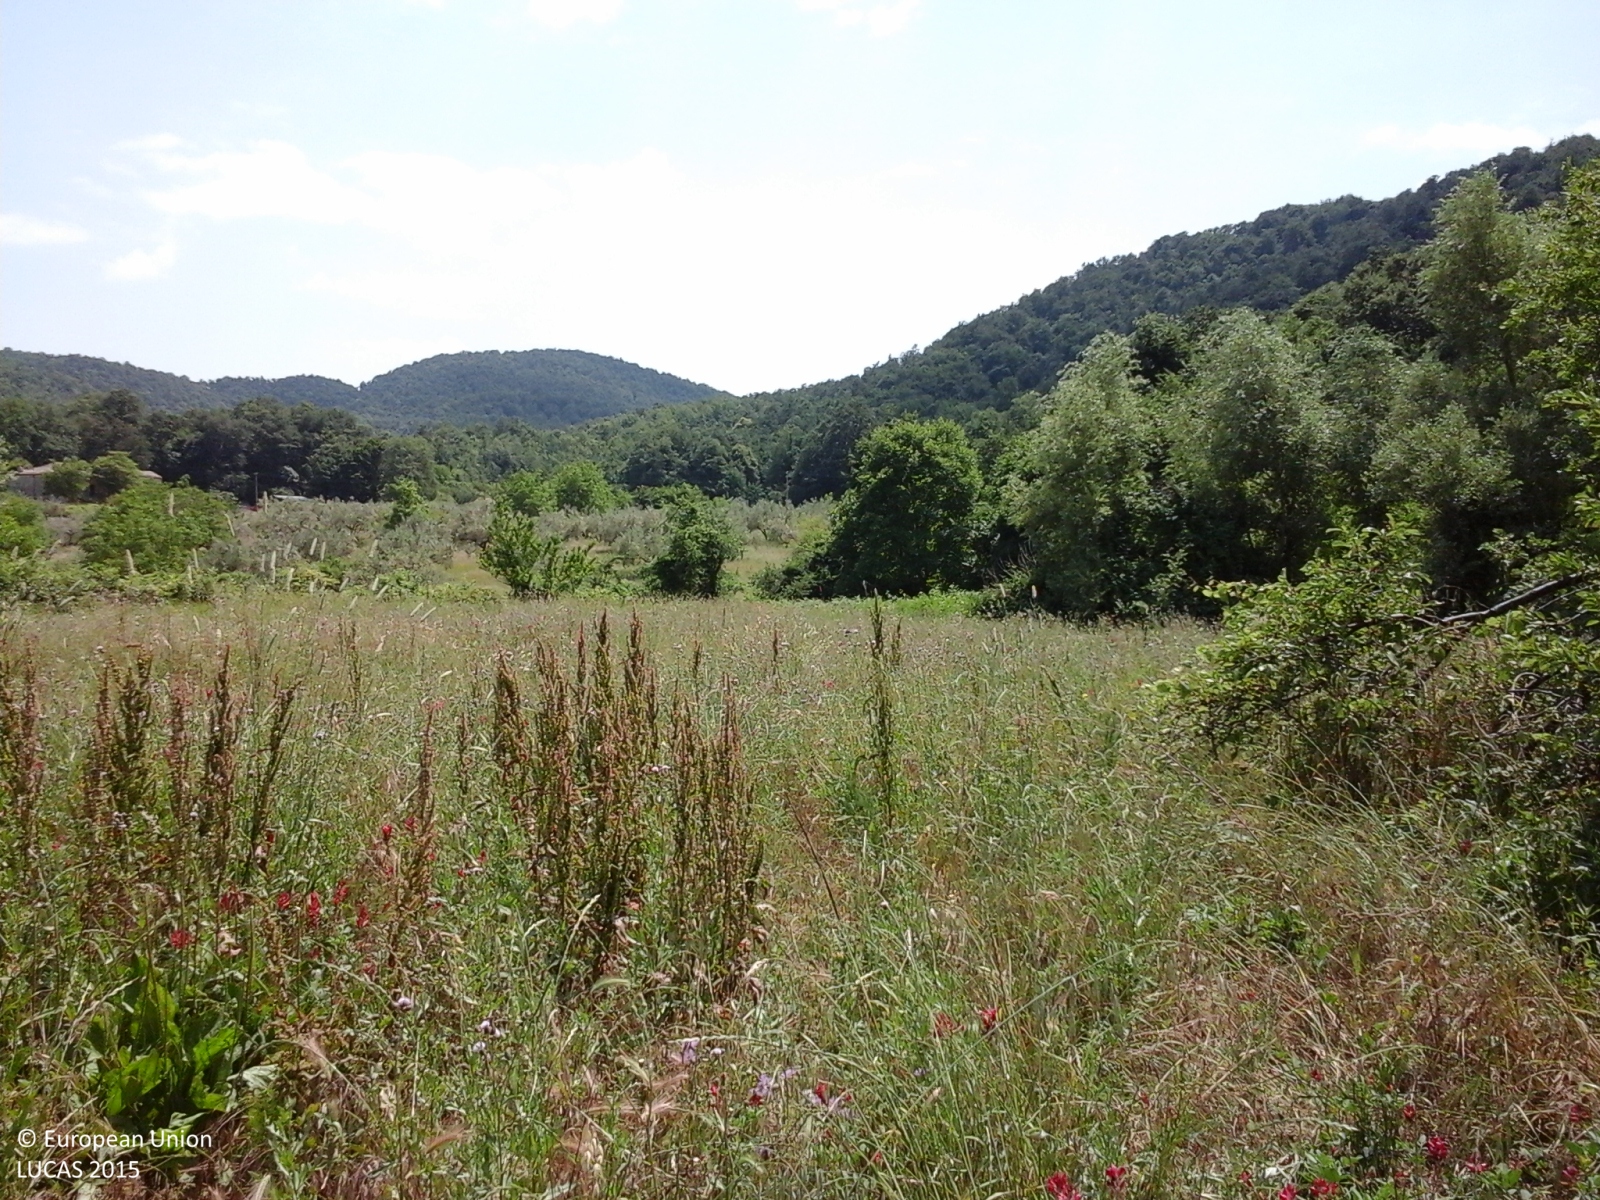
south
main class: Shrubland
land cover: Shrubland with sparse tree cover
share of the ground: > 75 %
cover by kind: shrubs 90 %, broadleaved forest trees 5 %, herbaceous plants 5 %
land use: Semi-natural and natural areas not in use
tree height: < 5 m
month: June
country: IT
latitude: 42.0701
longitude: 14.3975
